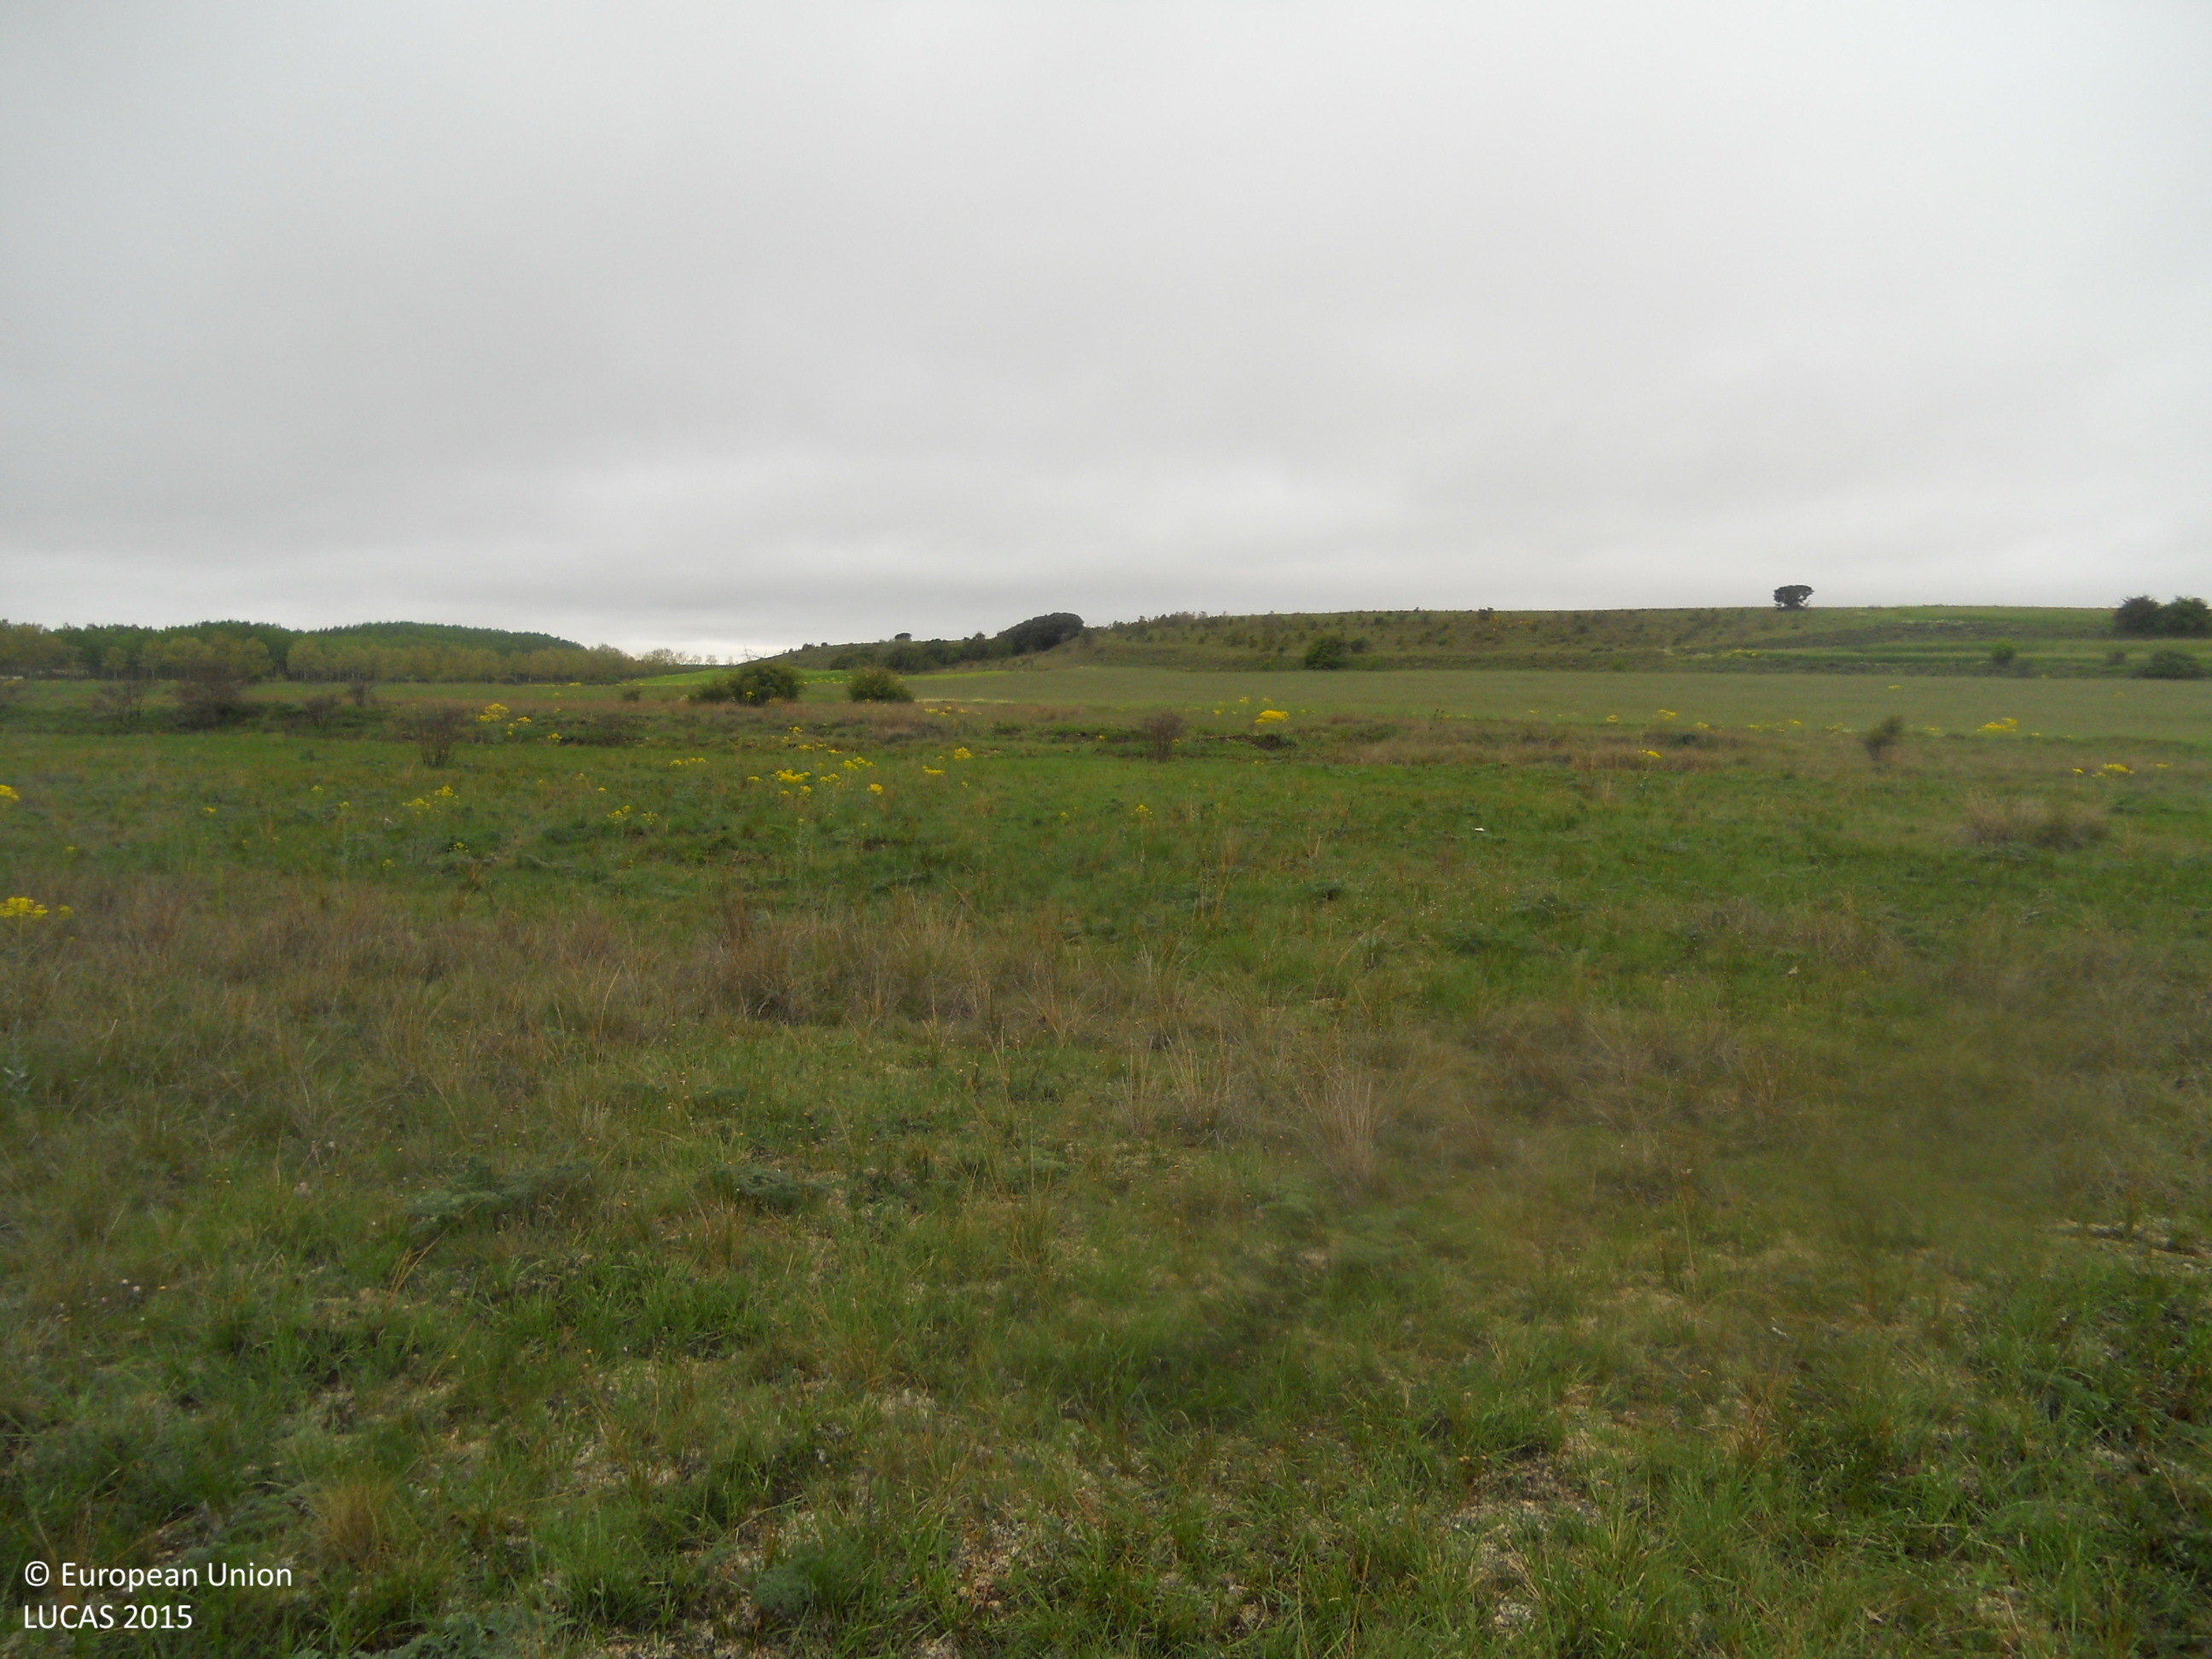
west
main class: Grassland
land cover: Grassland without tree/shrub cover
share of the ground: > 75 %
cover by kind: herbaceous plants 95 %, shrubs 5 %
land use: Agriculture (excluding fallow land and kitchen gardens)
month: May
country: ES
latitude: 42.4697
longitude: -5.3305
